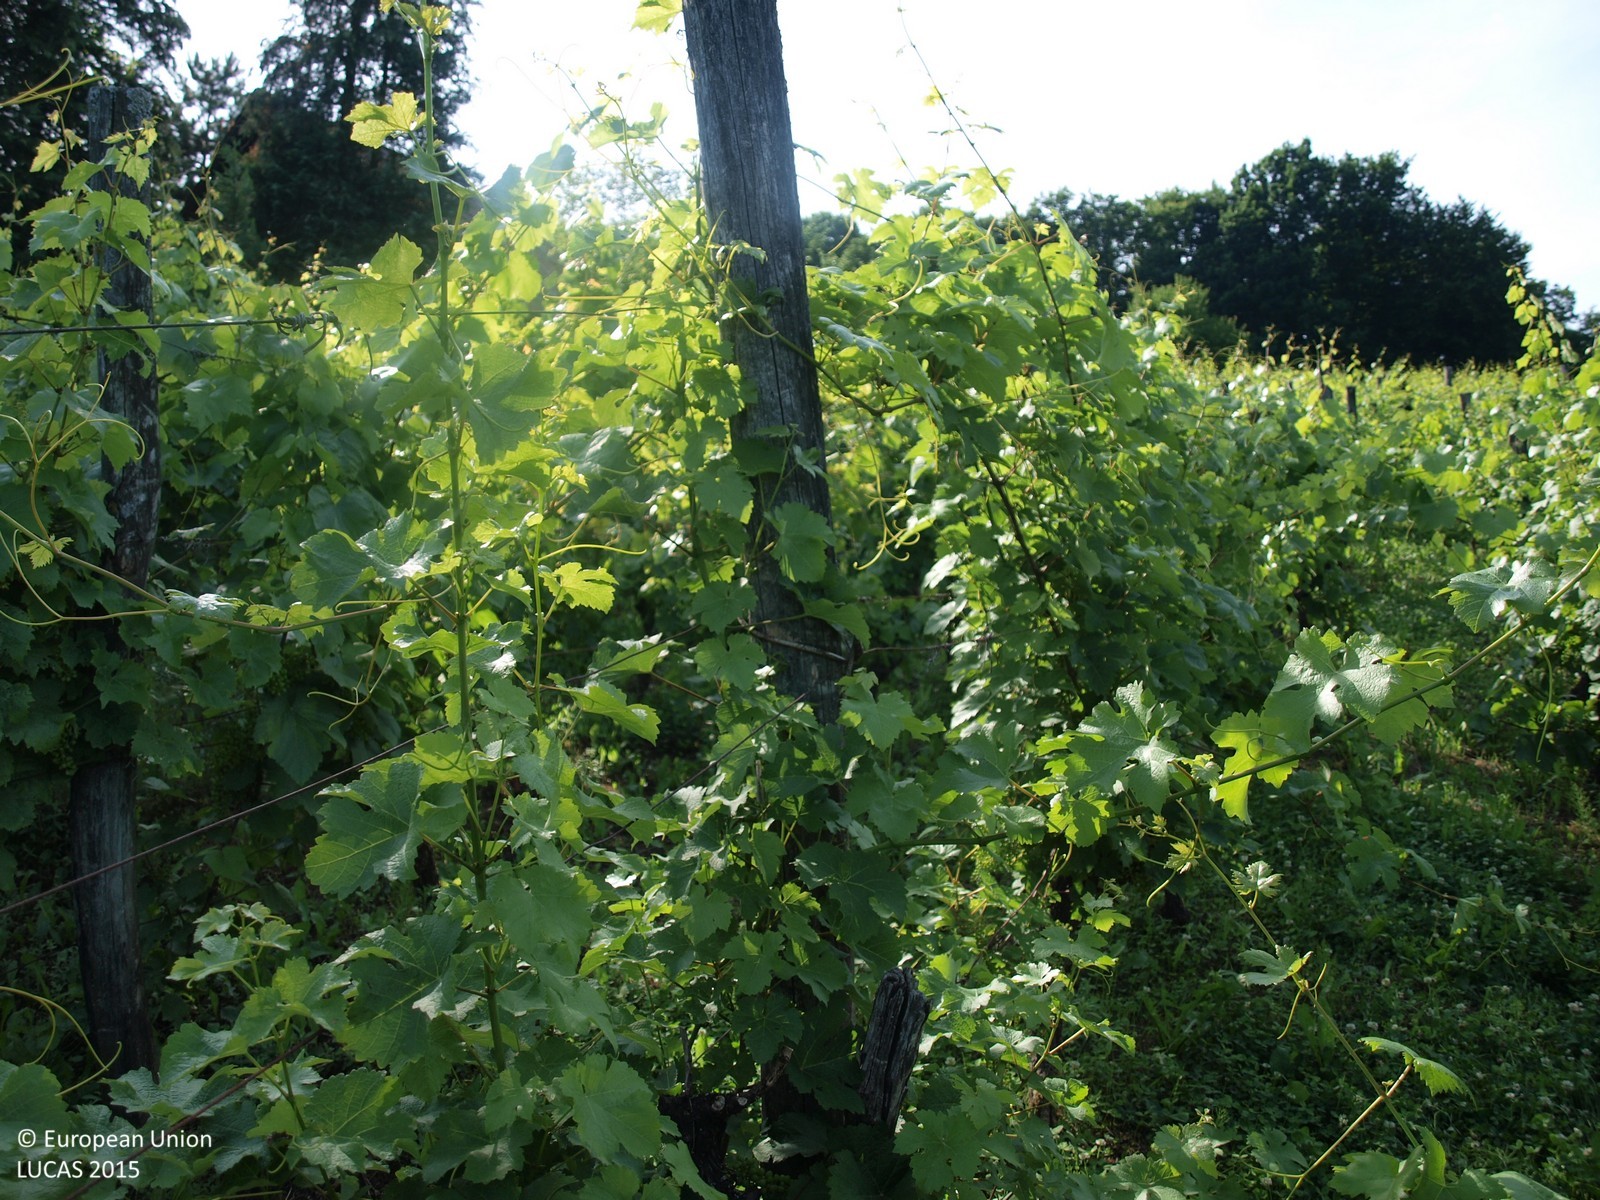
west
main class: Cropland
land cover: Vineyards
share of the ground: > 75 %
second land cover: Grassland without tree/shrub cover
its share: 10 - 25 %
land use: Agriculture (excluding fallow land and kitchen gardens)
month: June
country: HR
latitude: 45.9803
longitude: 15.7419
